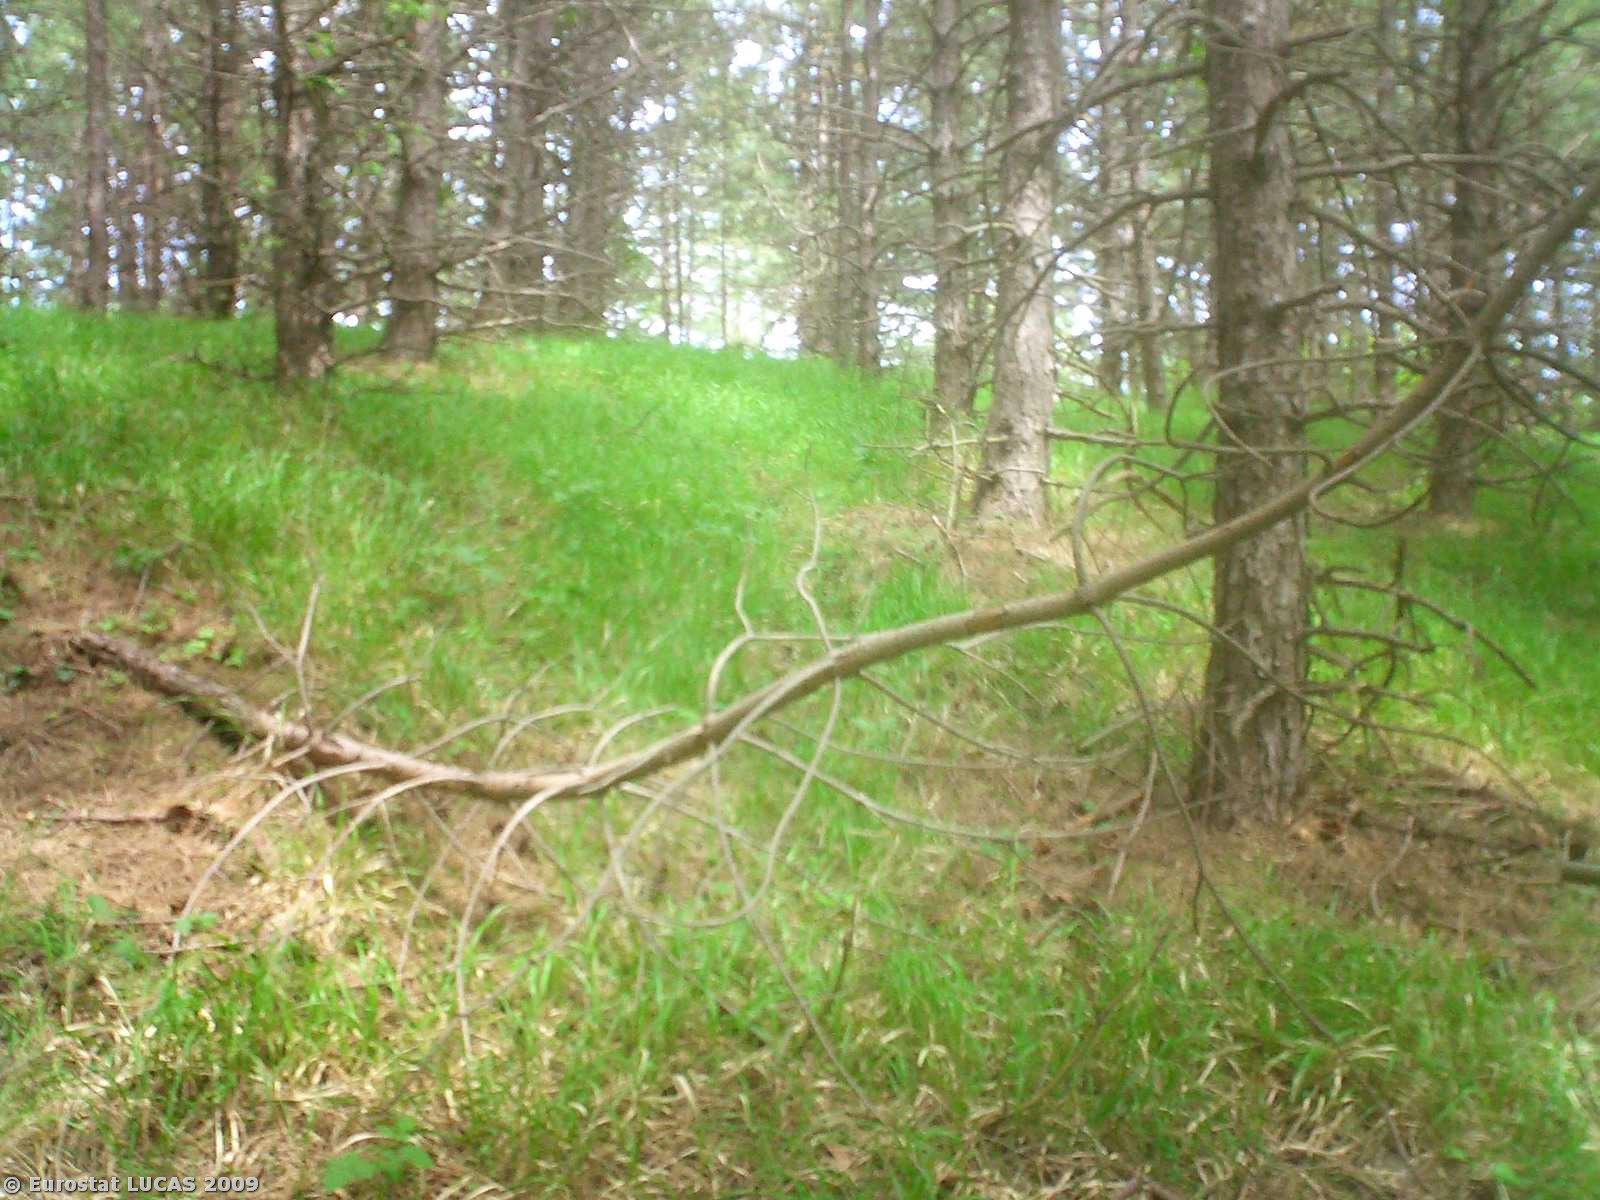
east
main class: Woodland
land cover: Coniferous woodland
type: alpine coniferous forest
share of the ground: 50 - 75 %
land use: Forestry
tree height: > 5 m
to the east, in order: Coniferous woodland; Barley; Other leguminous and mixtures for fodder; Electric lines; Other leguminous and mixtures for fodder; Shruby margins; Paved roads, cycling and walking lanes; Coniferous woodland
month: May
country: IT
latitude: 44.1392
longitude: 11.6337
